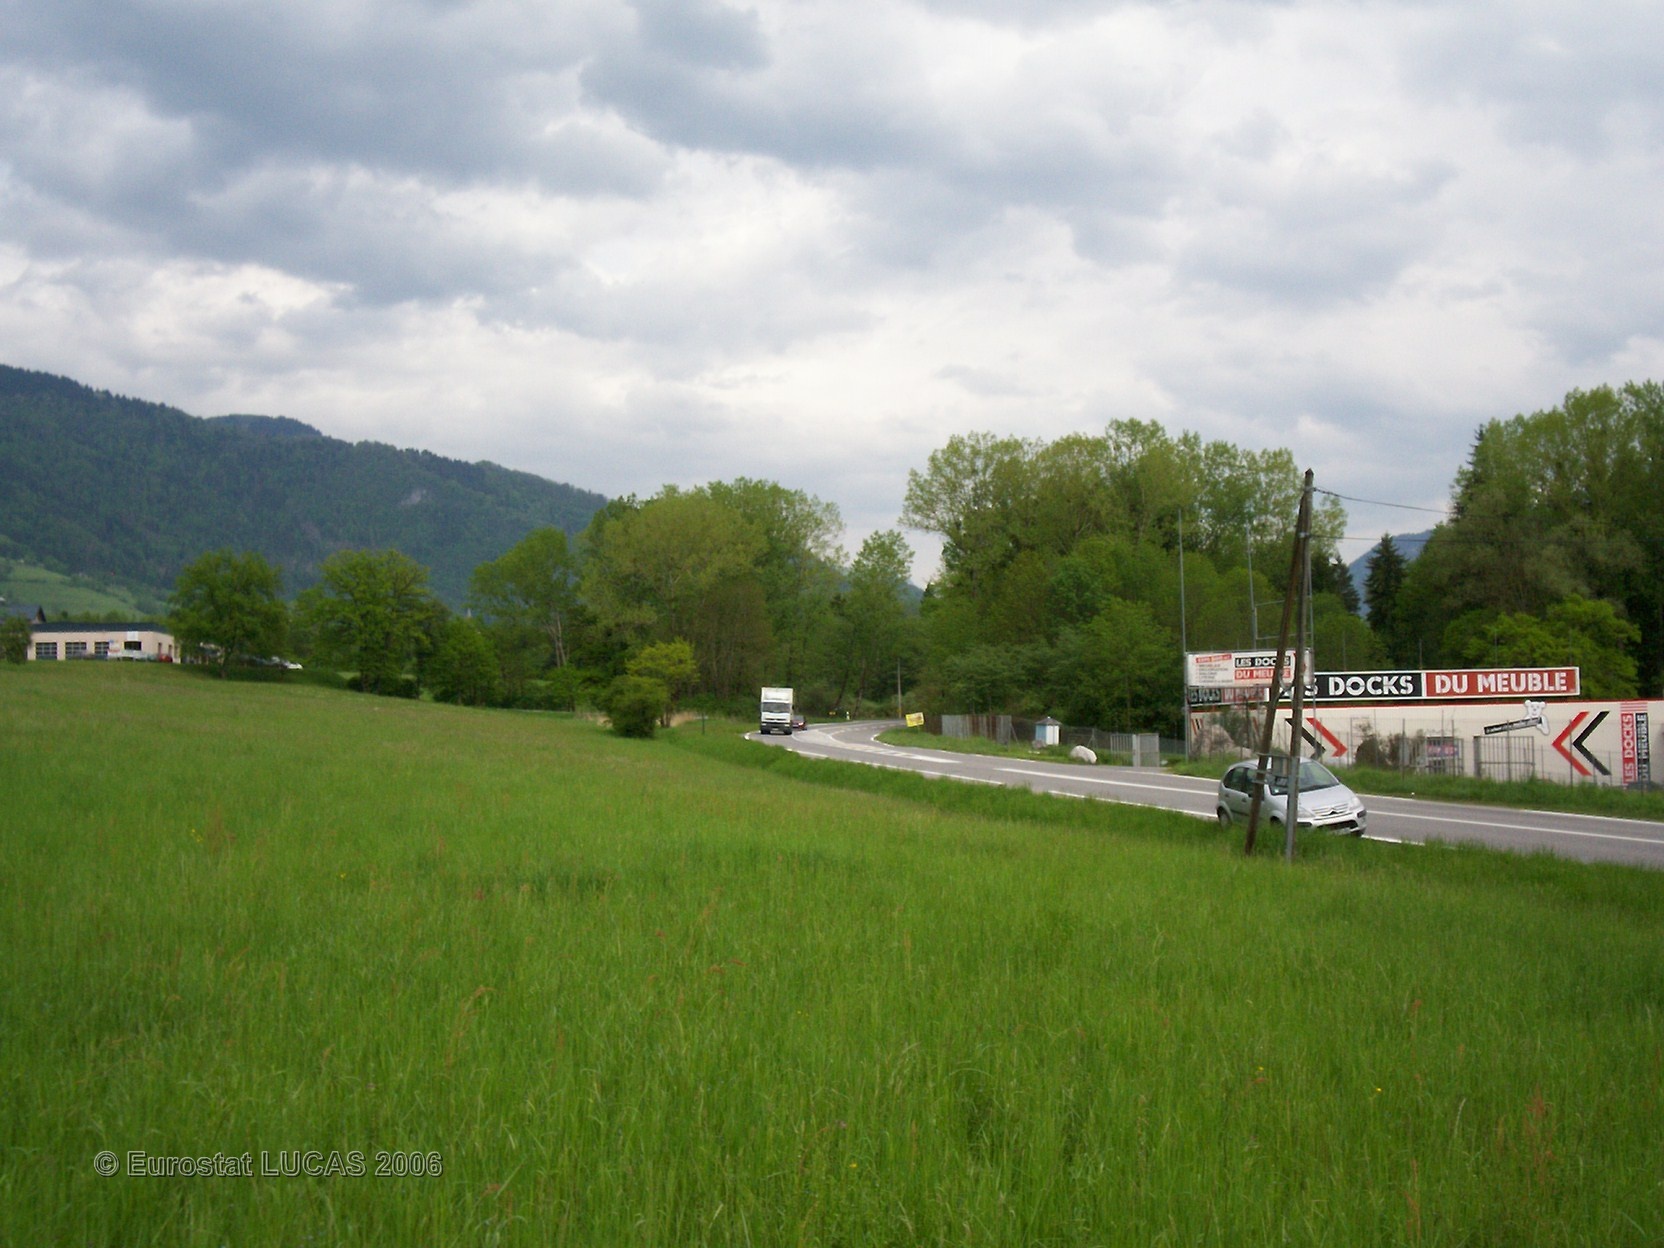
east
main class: Grassland
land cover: Grassland without tree/shrub cover
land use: Agriculture (excluding fallow land and kitchen gardens)
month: May
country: FR
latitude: 46.1461
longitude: 6.3915
